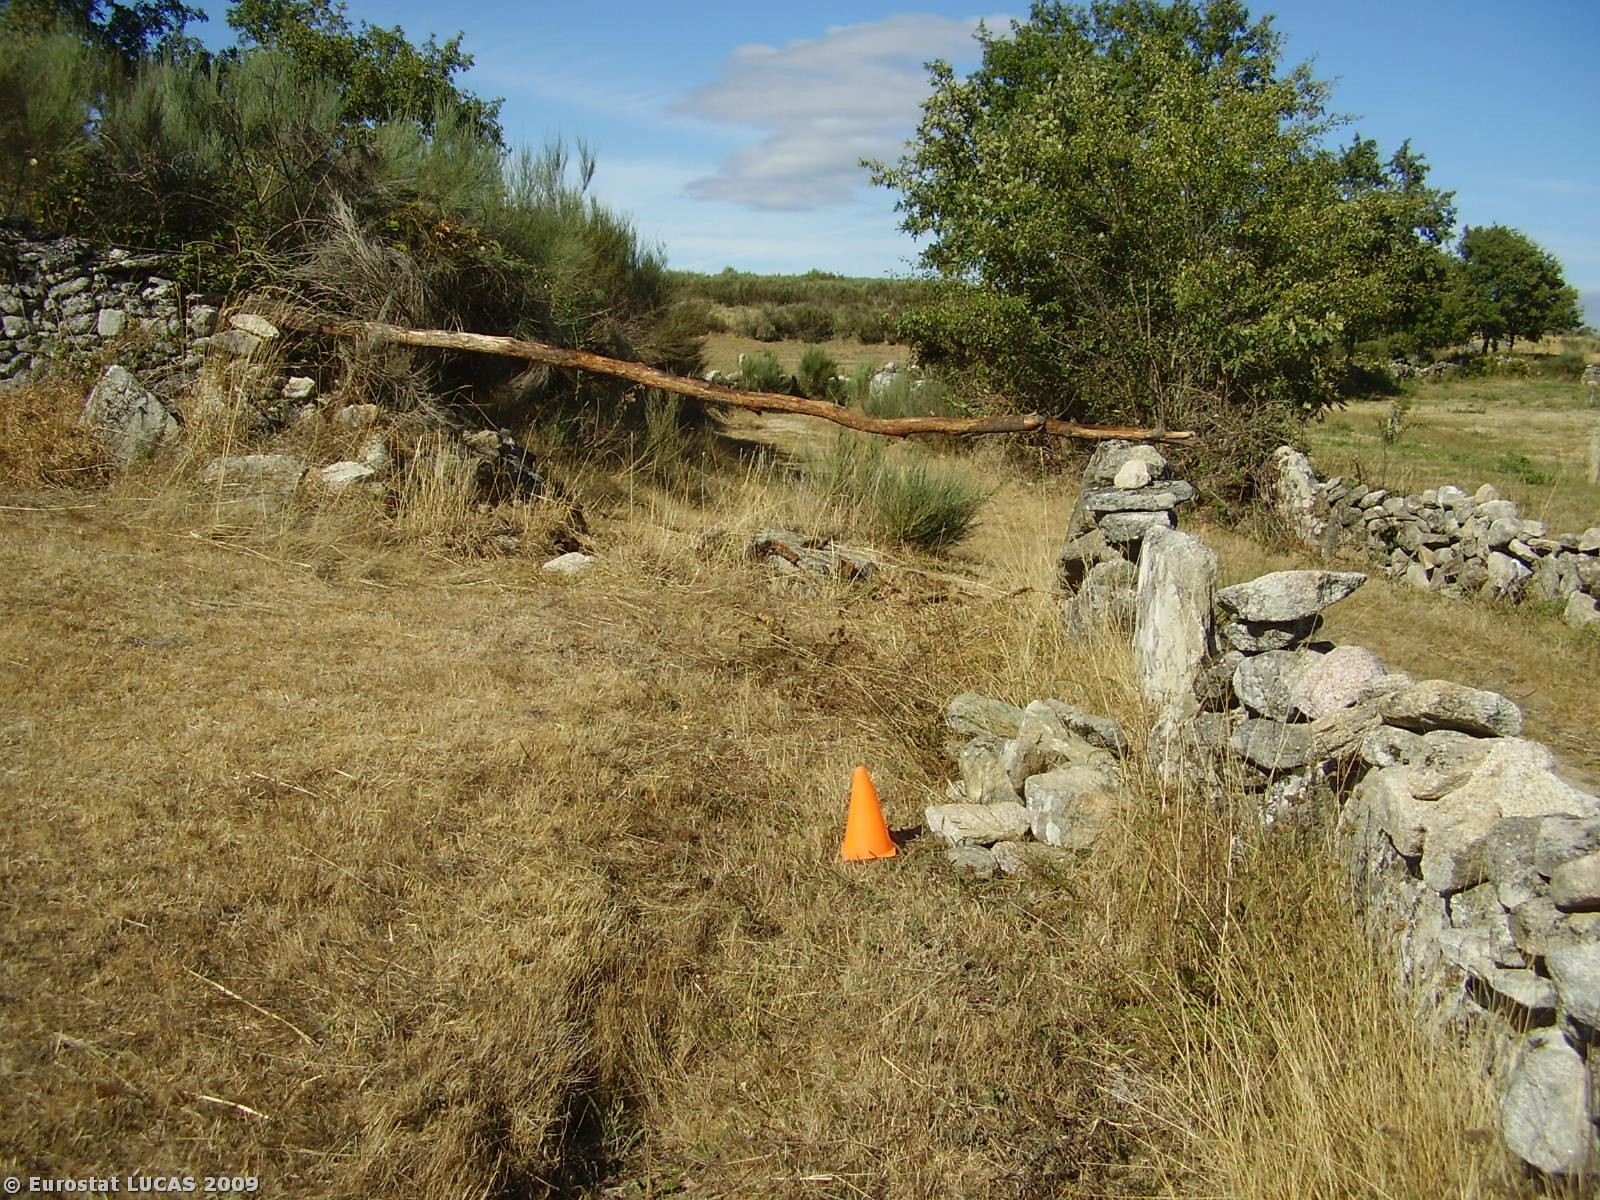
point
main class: Grassland
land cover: Grassland without tree/shrub cover
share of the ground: > 75 %
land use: Fallow land
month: September
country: PT
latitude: 41.7696
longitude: -7.6627
